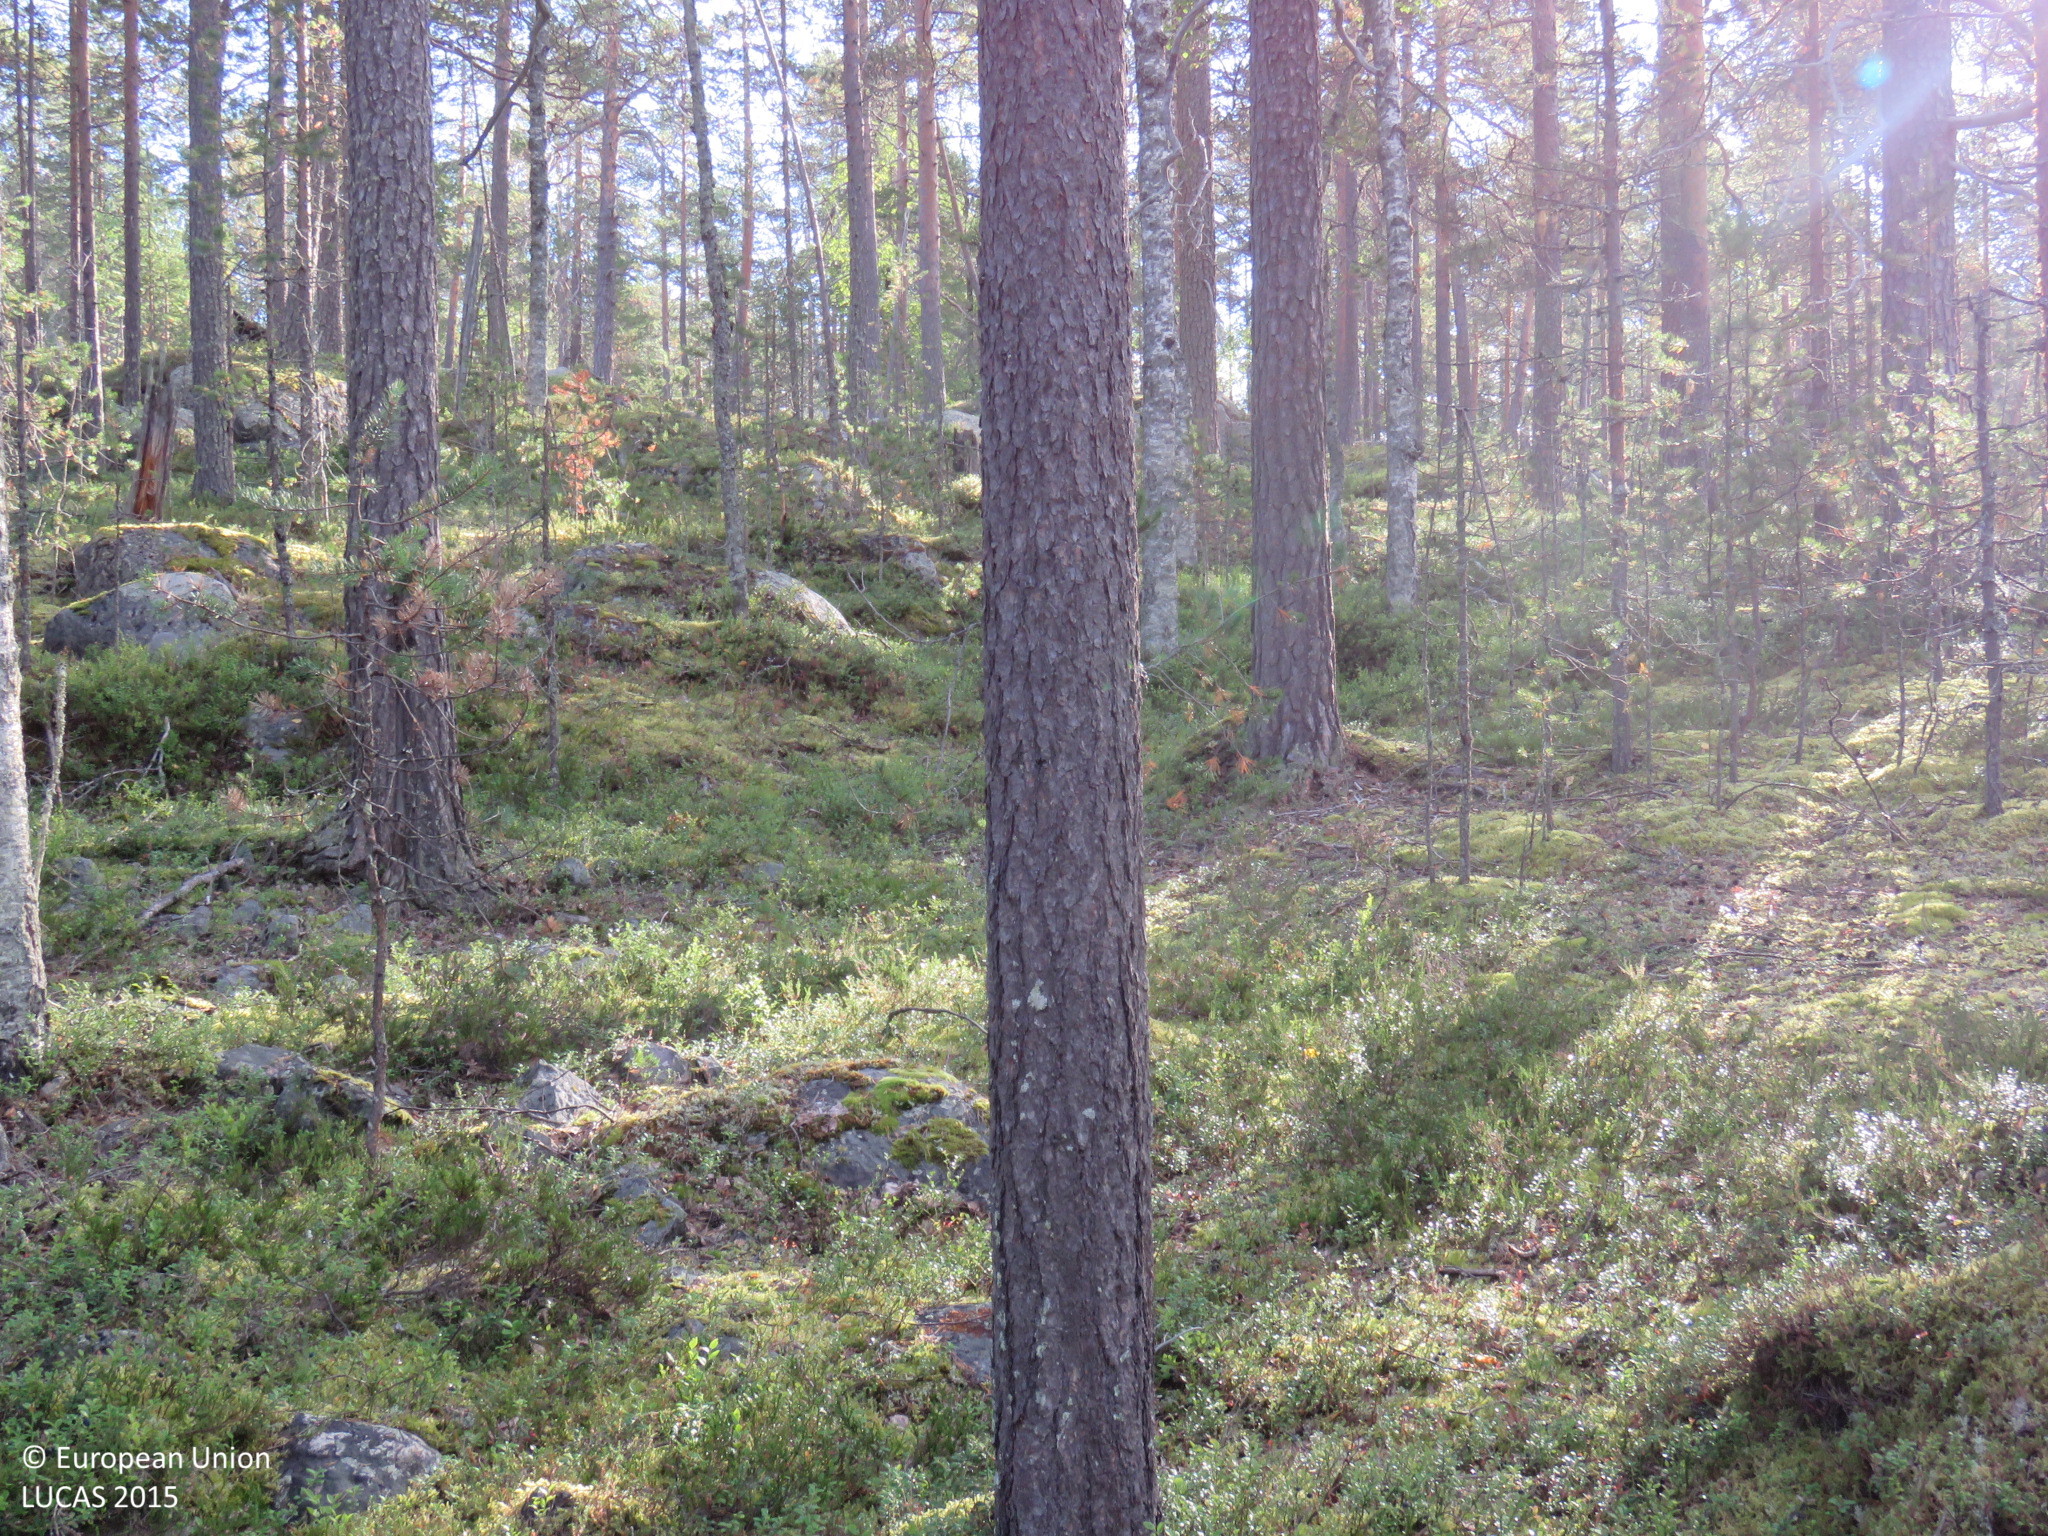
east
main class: Woodland
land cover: Pine dominated coniferous woodland
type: boreal forest
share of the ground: > 75 %
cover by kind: coniferous forest trees 75 %, shrubs 10 %, lichens and mosses 10 %, broadleaved forest trees 5 %
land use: Forestry
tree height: > 5 m
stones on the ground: < 10 %
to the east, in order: Pine dominated coniferous woodland; Rocks and stones; Pine dominated coniferous woodland
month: September
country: FI
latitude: 65.3573
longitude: 27.4320
